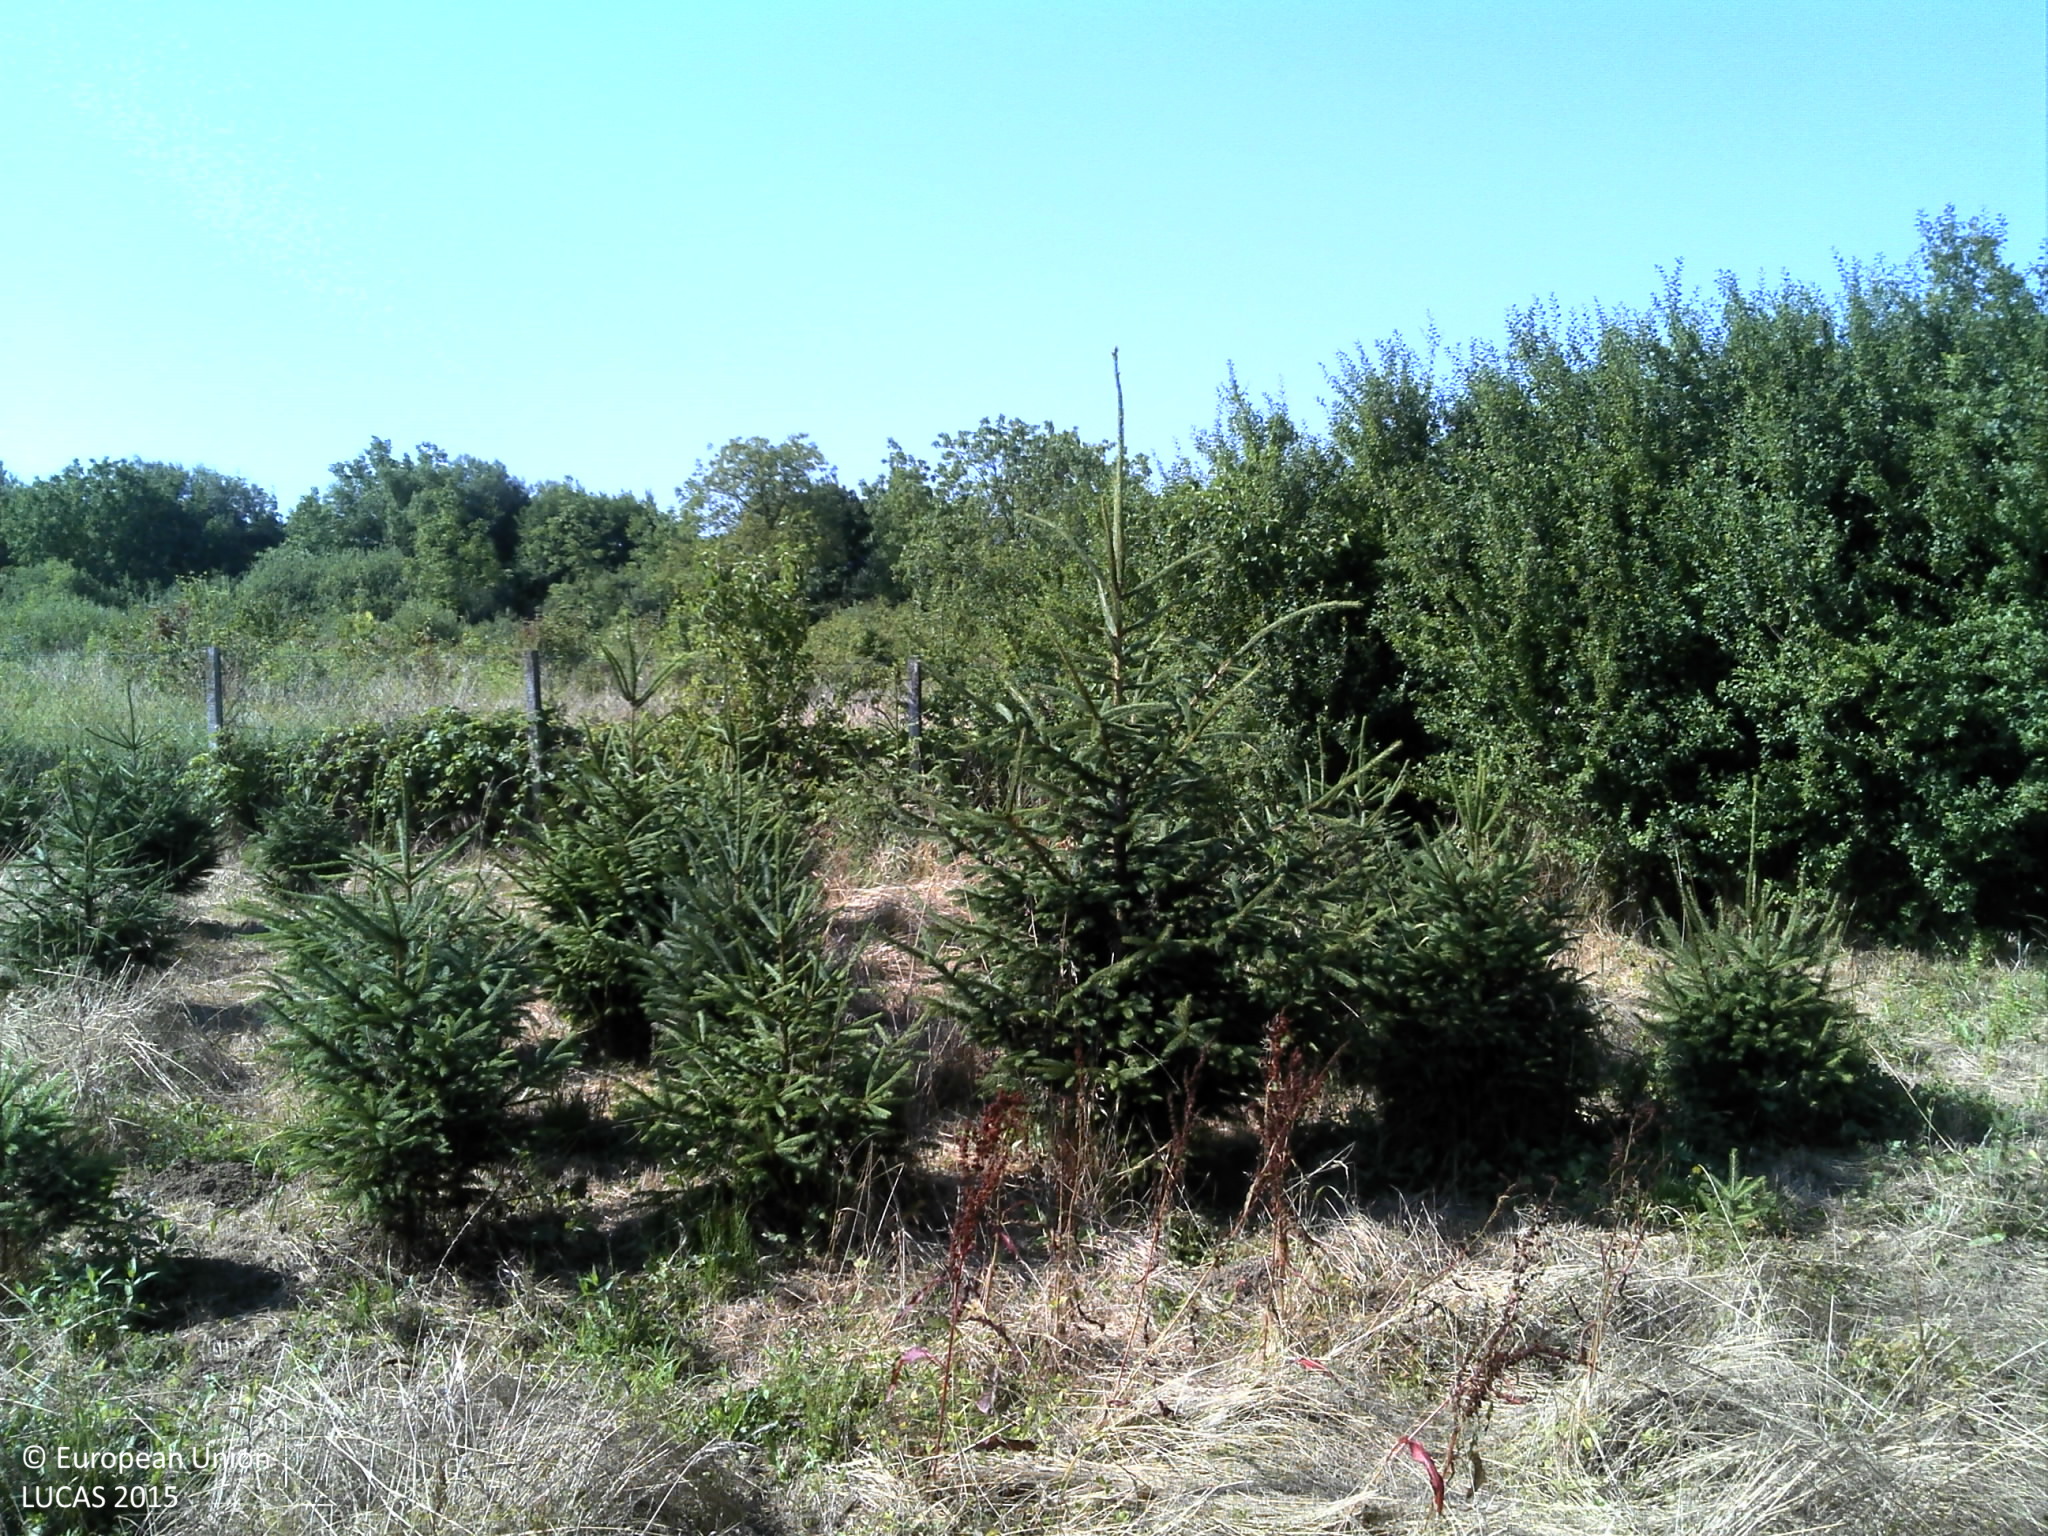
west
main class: Cropland
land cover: Nurseries
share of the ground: 10 - 25 %
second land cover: Spontaneously vegetated surfaces
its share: > 75 %
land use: Agriculture (excluding fallow land and kitchen gardens)
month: June
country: HR
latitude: 45.2462
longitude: 17.3768
